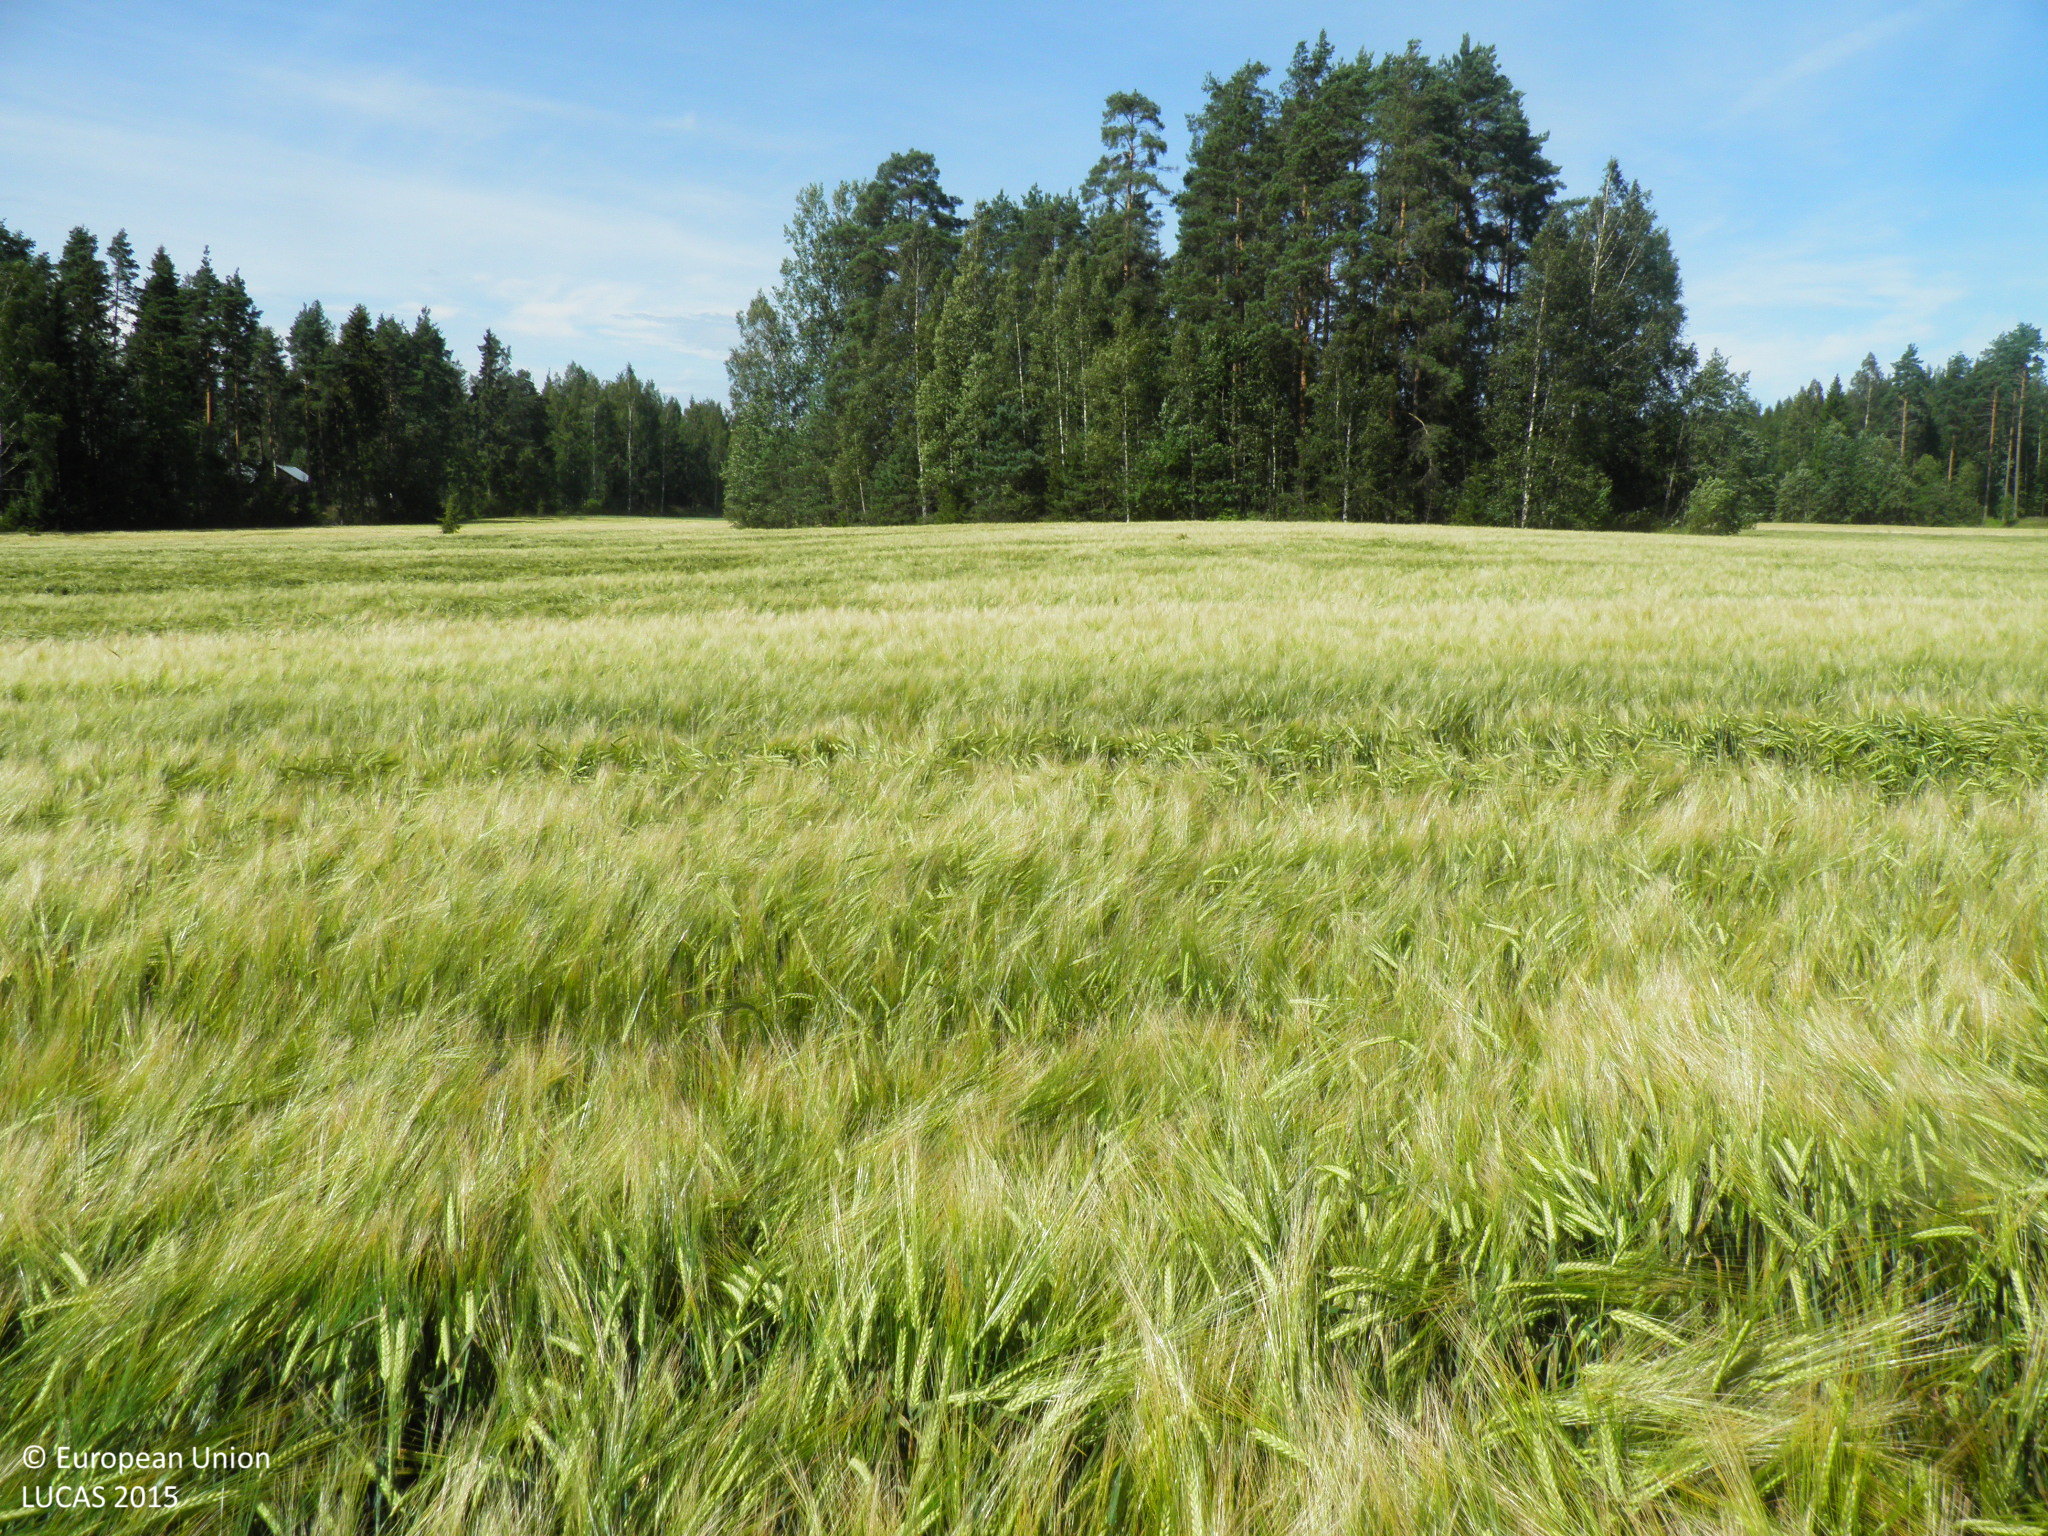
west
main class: Cropland
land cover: Barley
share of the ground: > 75 %
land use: Agriculture (excluding fallow land and kitchen gardens)
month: August
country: FI
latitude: 61.0185
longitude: 22.8193
